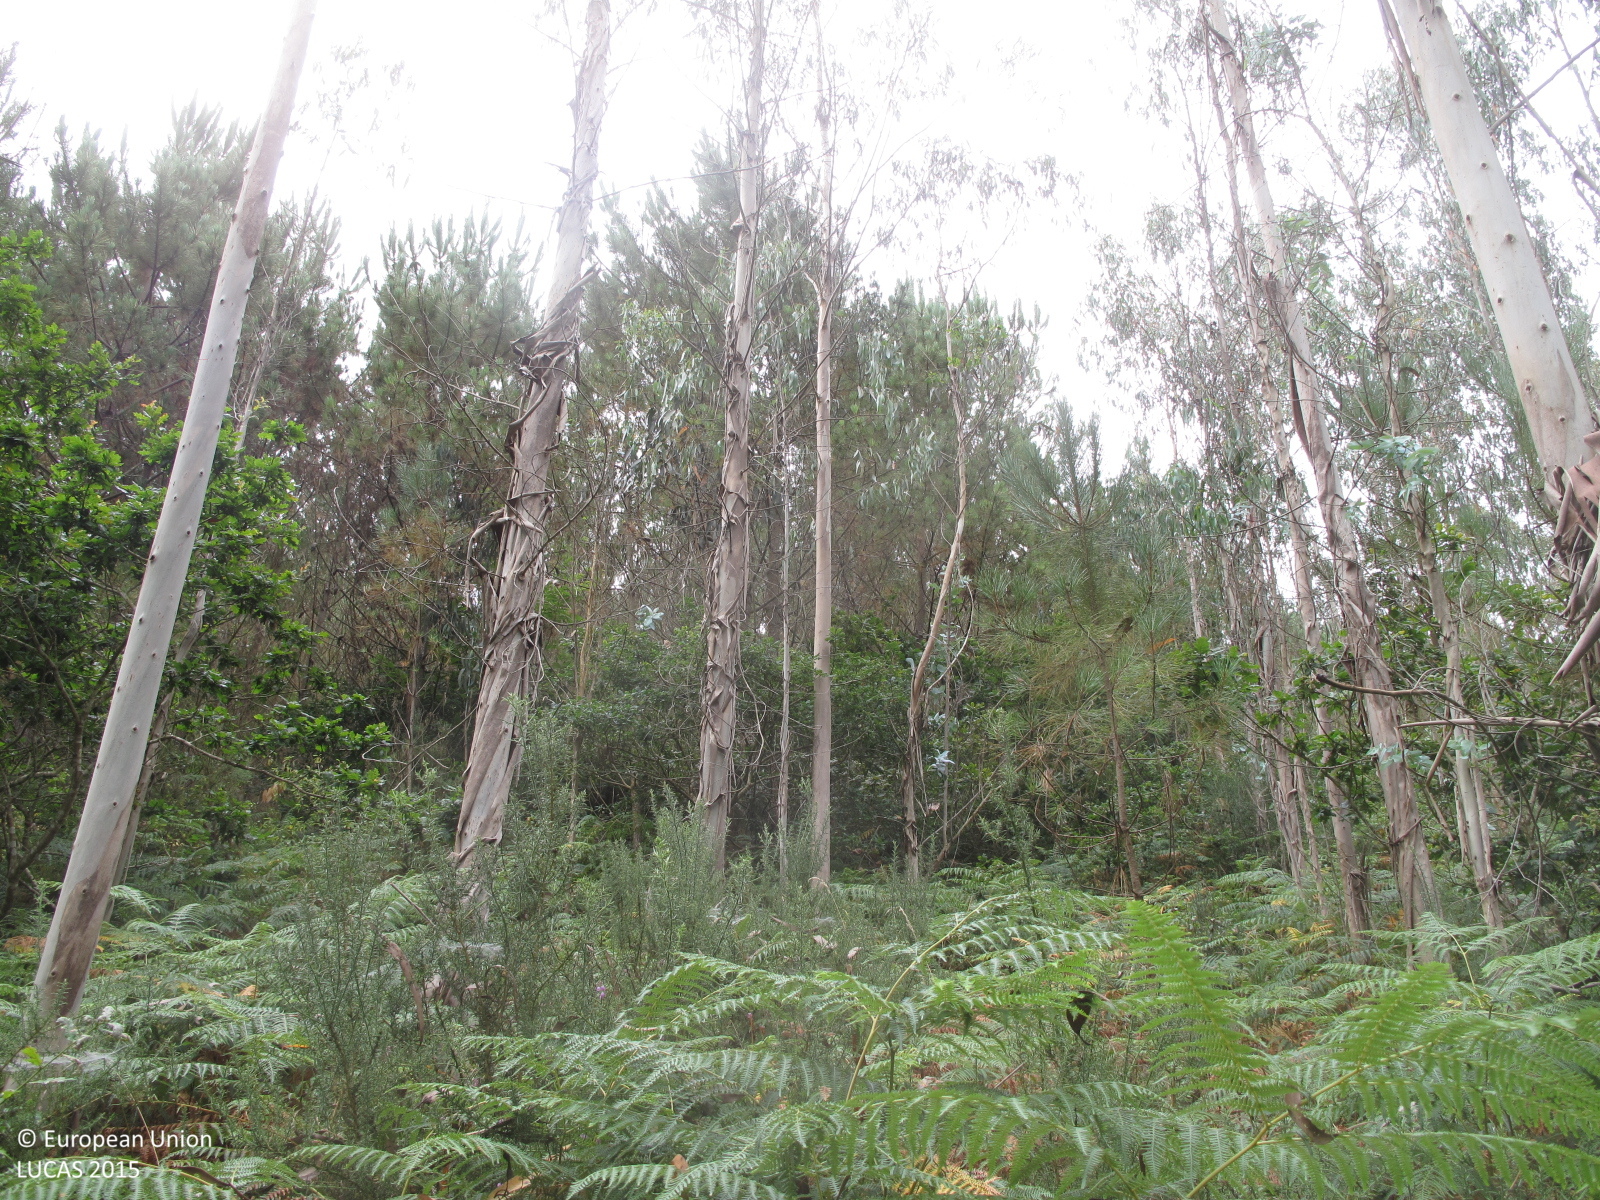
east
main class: Woodland
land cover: Broadleaved woodland
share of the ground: 25 - 50 %
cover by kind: herbaceous plants 50 %, broadleaved forest trees 40 %, shrubs 10 %
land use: Forestry
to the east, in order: Broadleaved woodland; Pine dominated coniferous woodland; Other mixed woodland; Pine dominated coniferous woodland; Pine dominated mixed woodland; Other mixed woodland
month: July
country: ES
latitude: 43.0554
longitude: -9.1959
